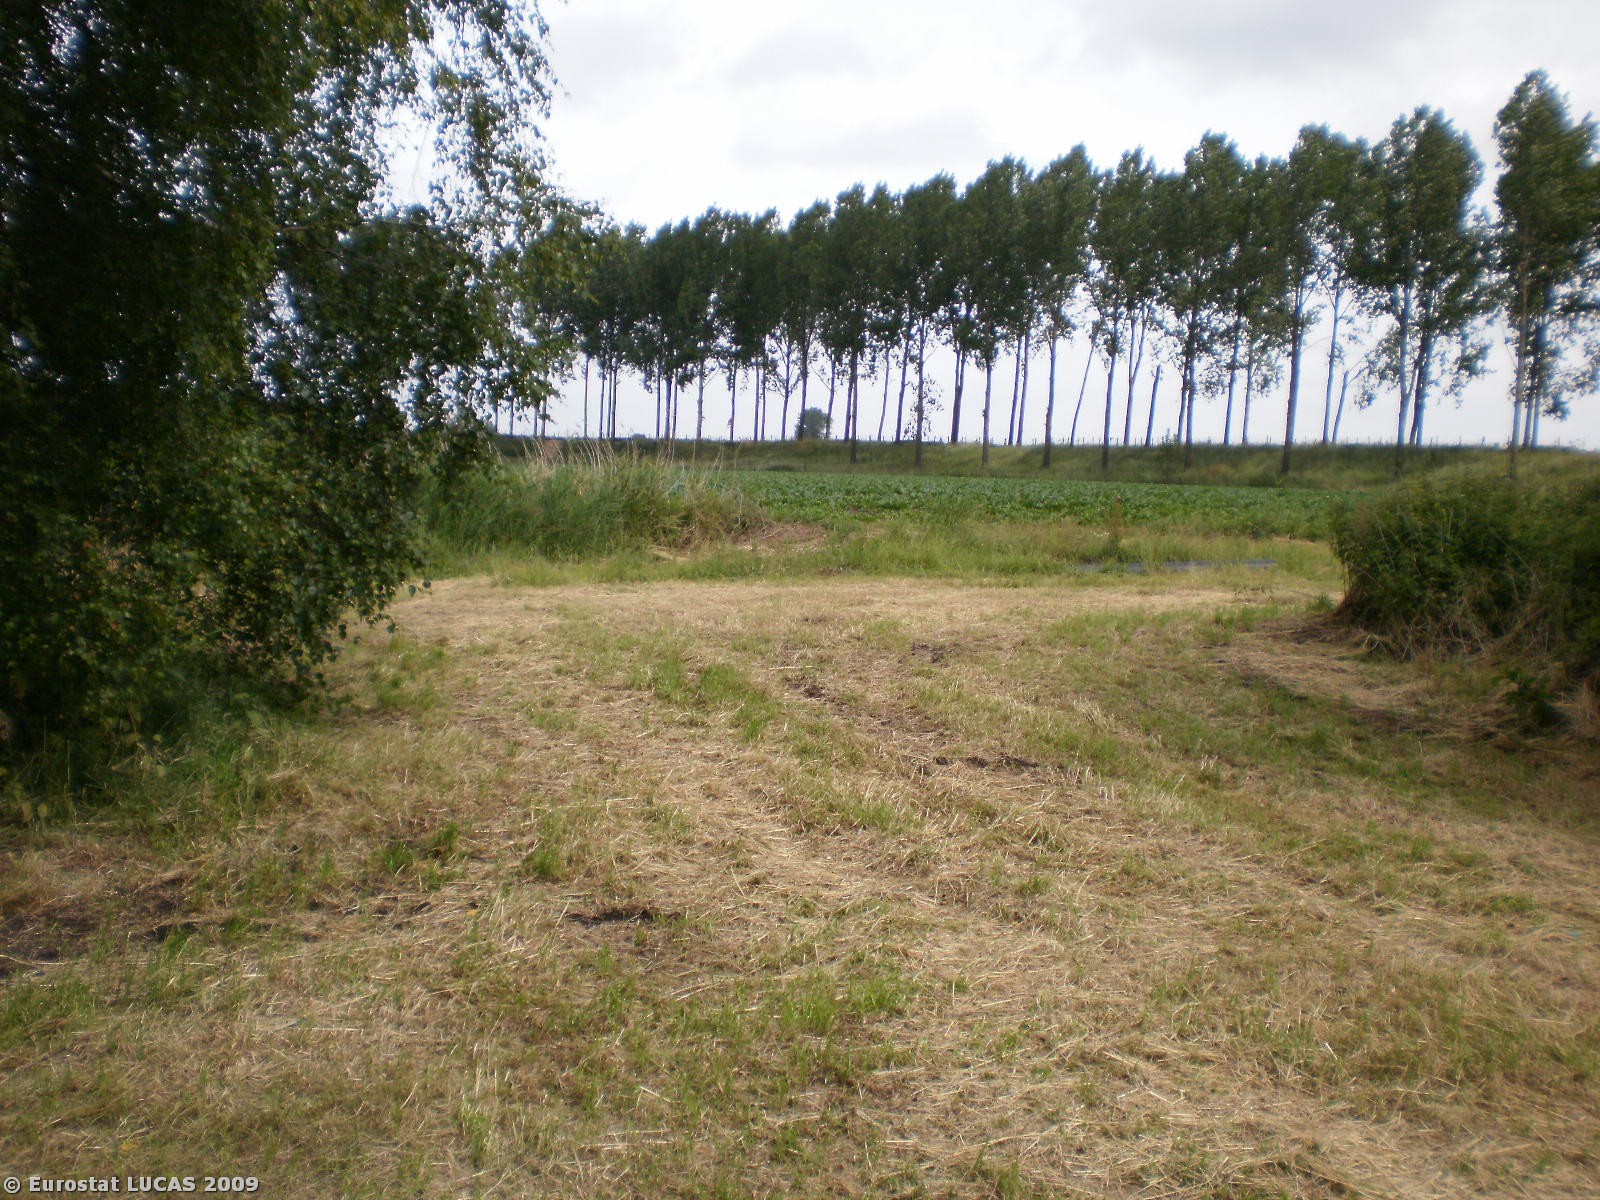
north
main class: Grassland
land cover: Grassland without tree/shrub cover
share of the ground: > 75 %
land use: Agriculture (excluding fallow land and kitchen gardens)
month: June
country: BE
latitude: 51.2799
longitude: 4.1885
